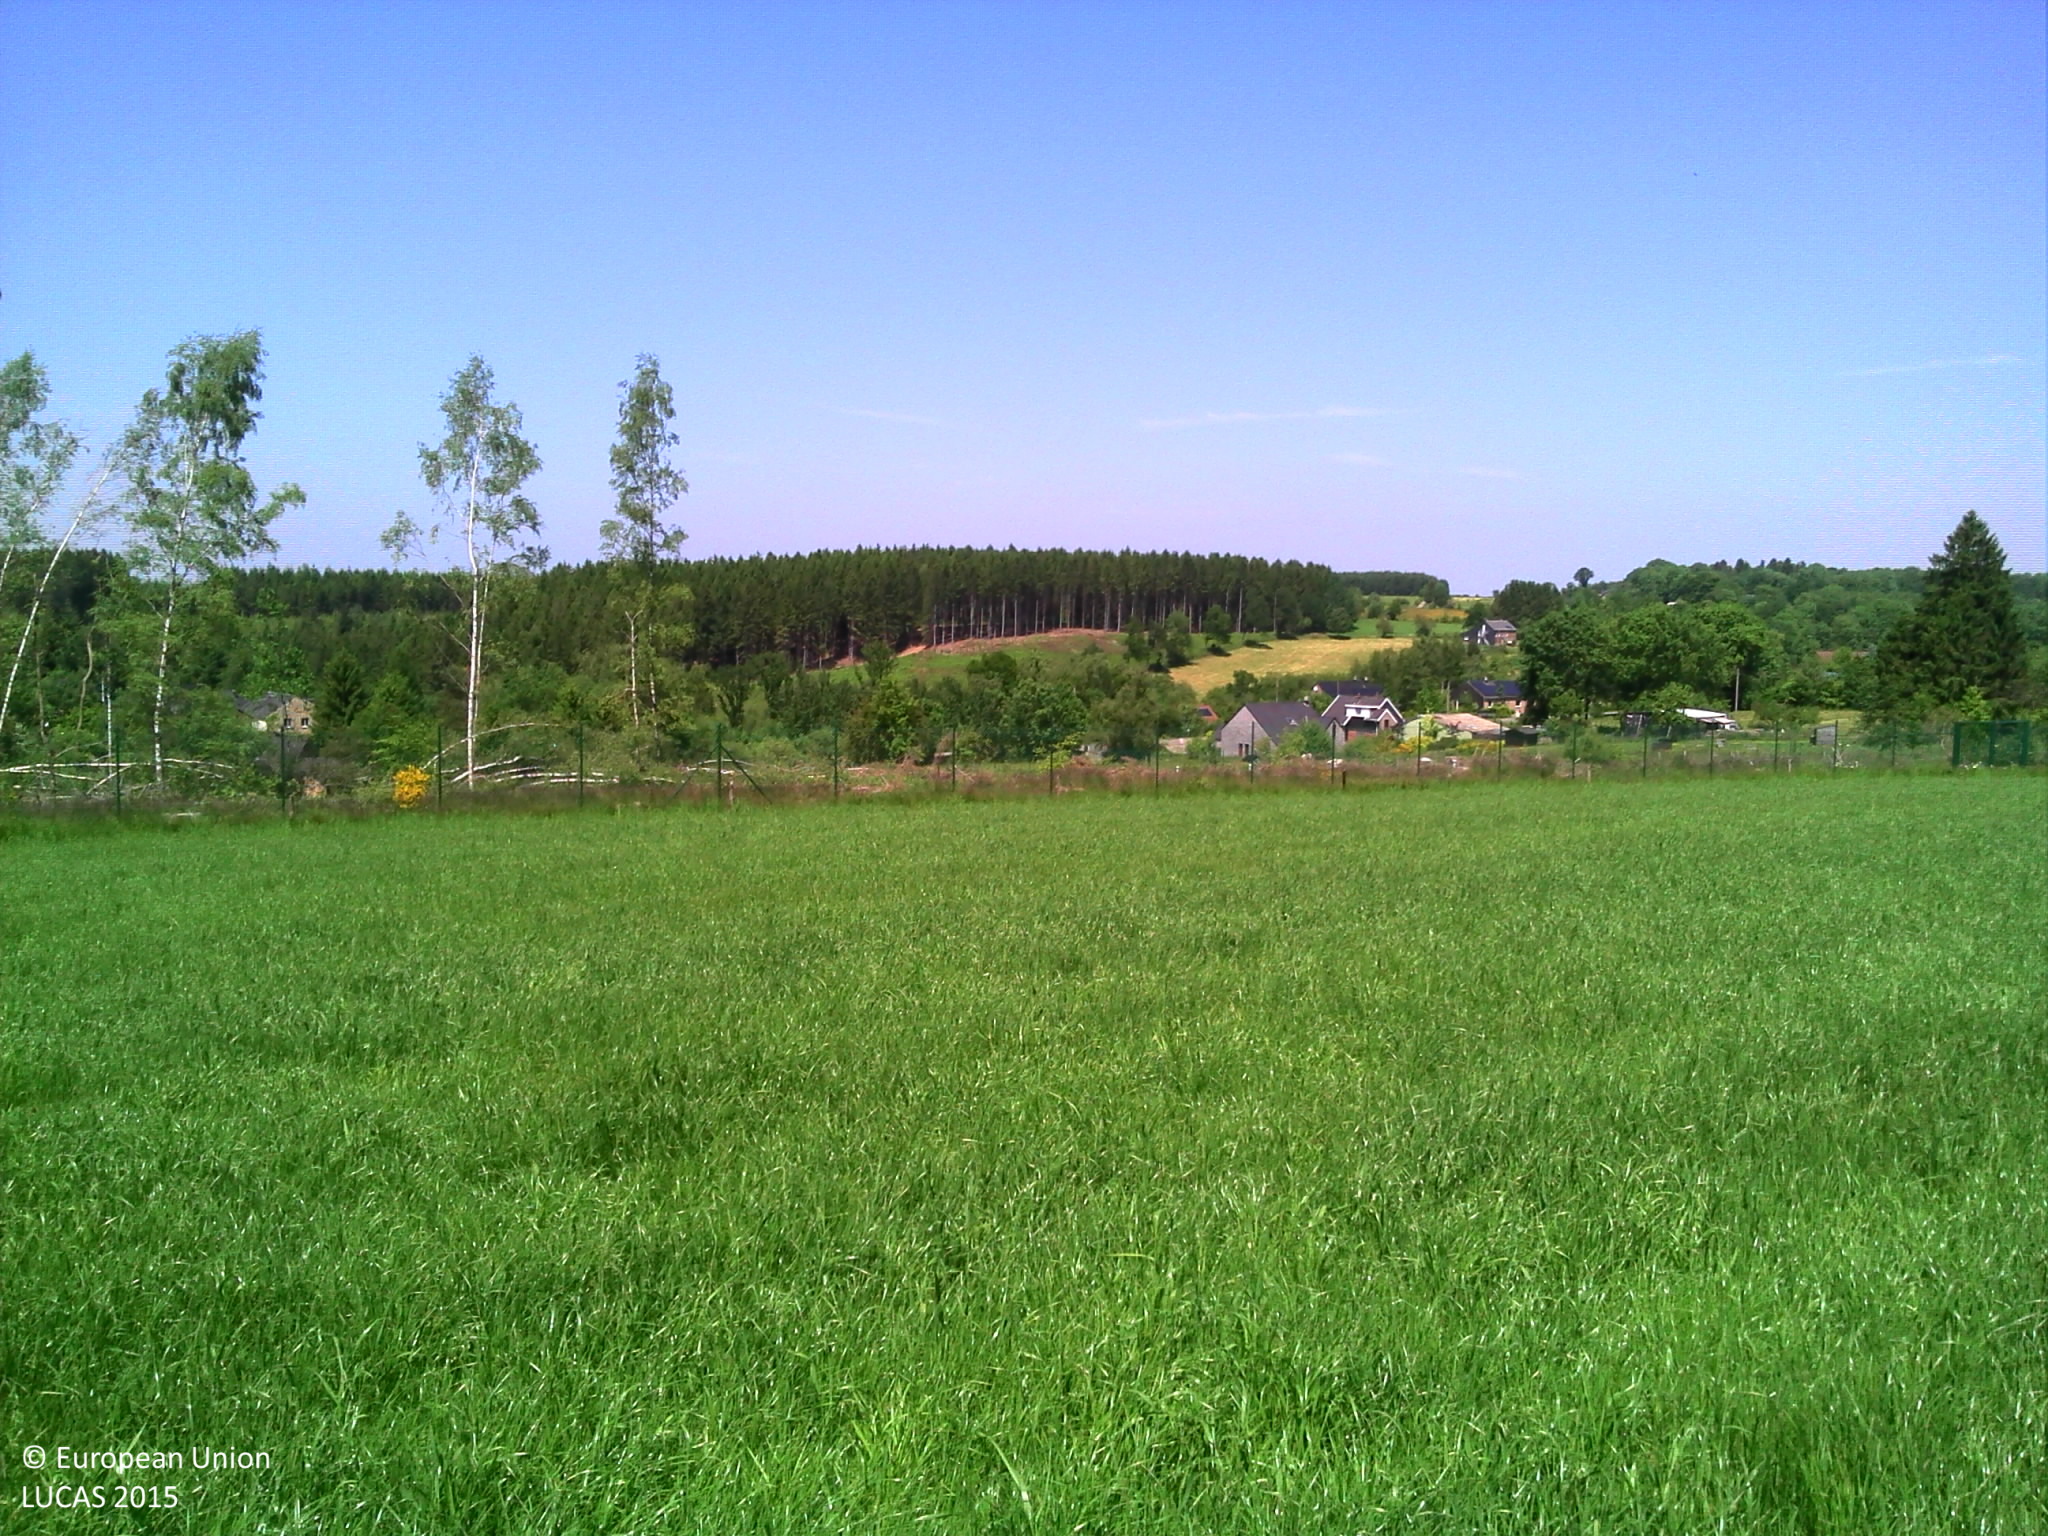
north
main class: Grassland
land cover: Grassland without tree/shrub cover
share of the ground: > 75 %
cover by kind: herbaceous plants 100 %
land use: Agriculture (excluding fallow land and kitchen gardens)
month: June
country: BE
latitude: 50.4834
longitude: 5.7565
